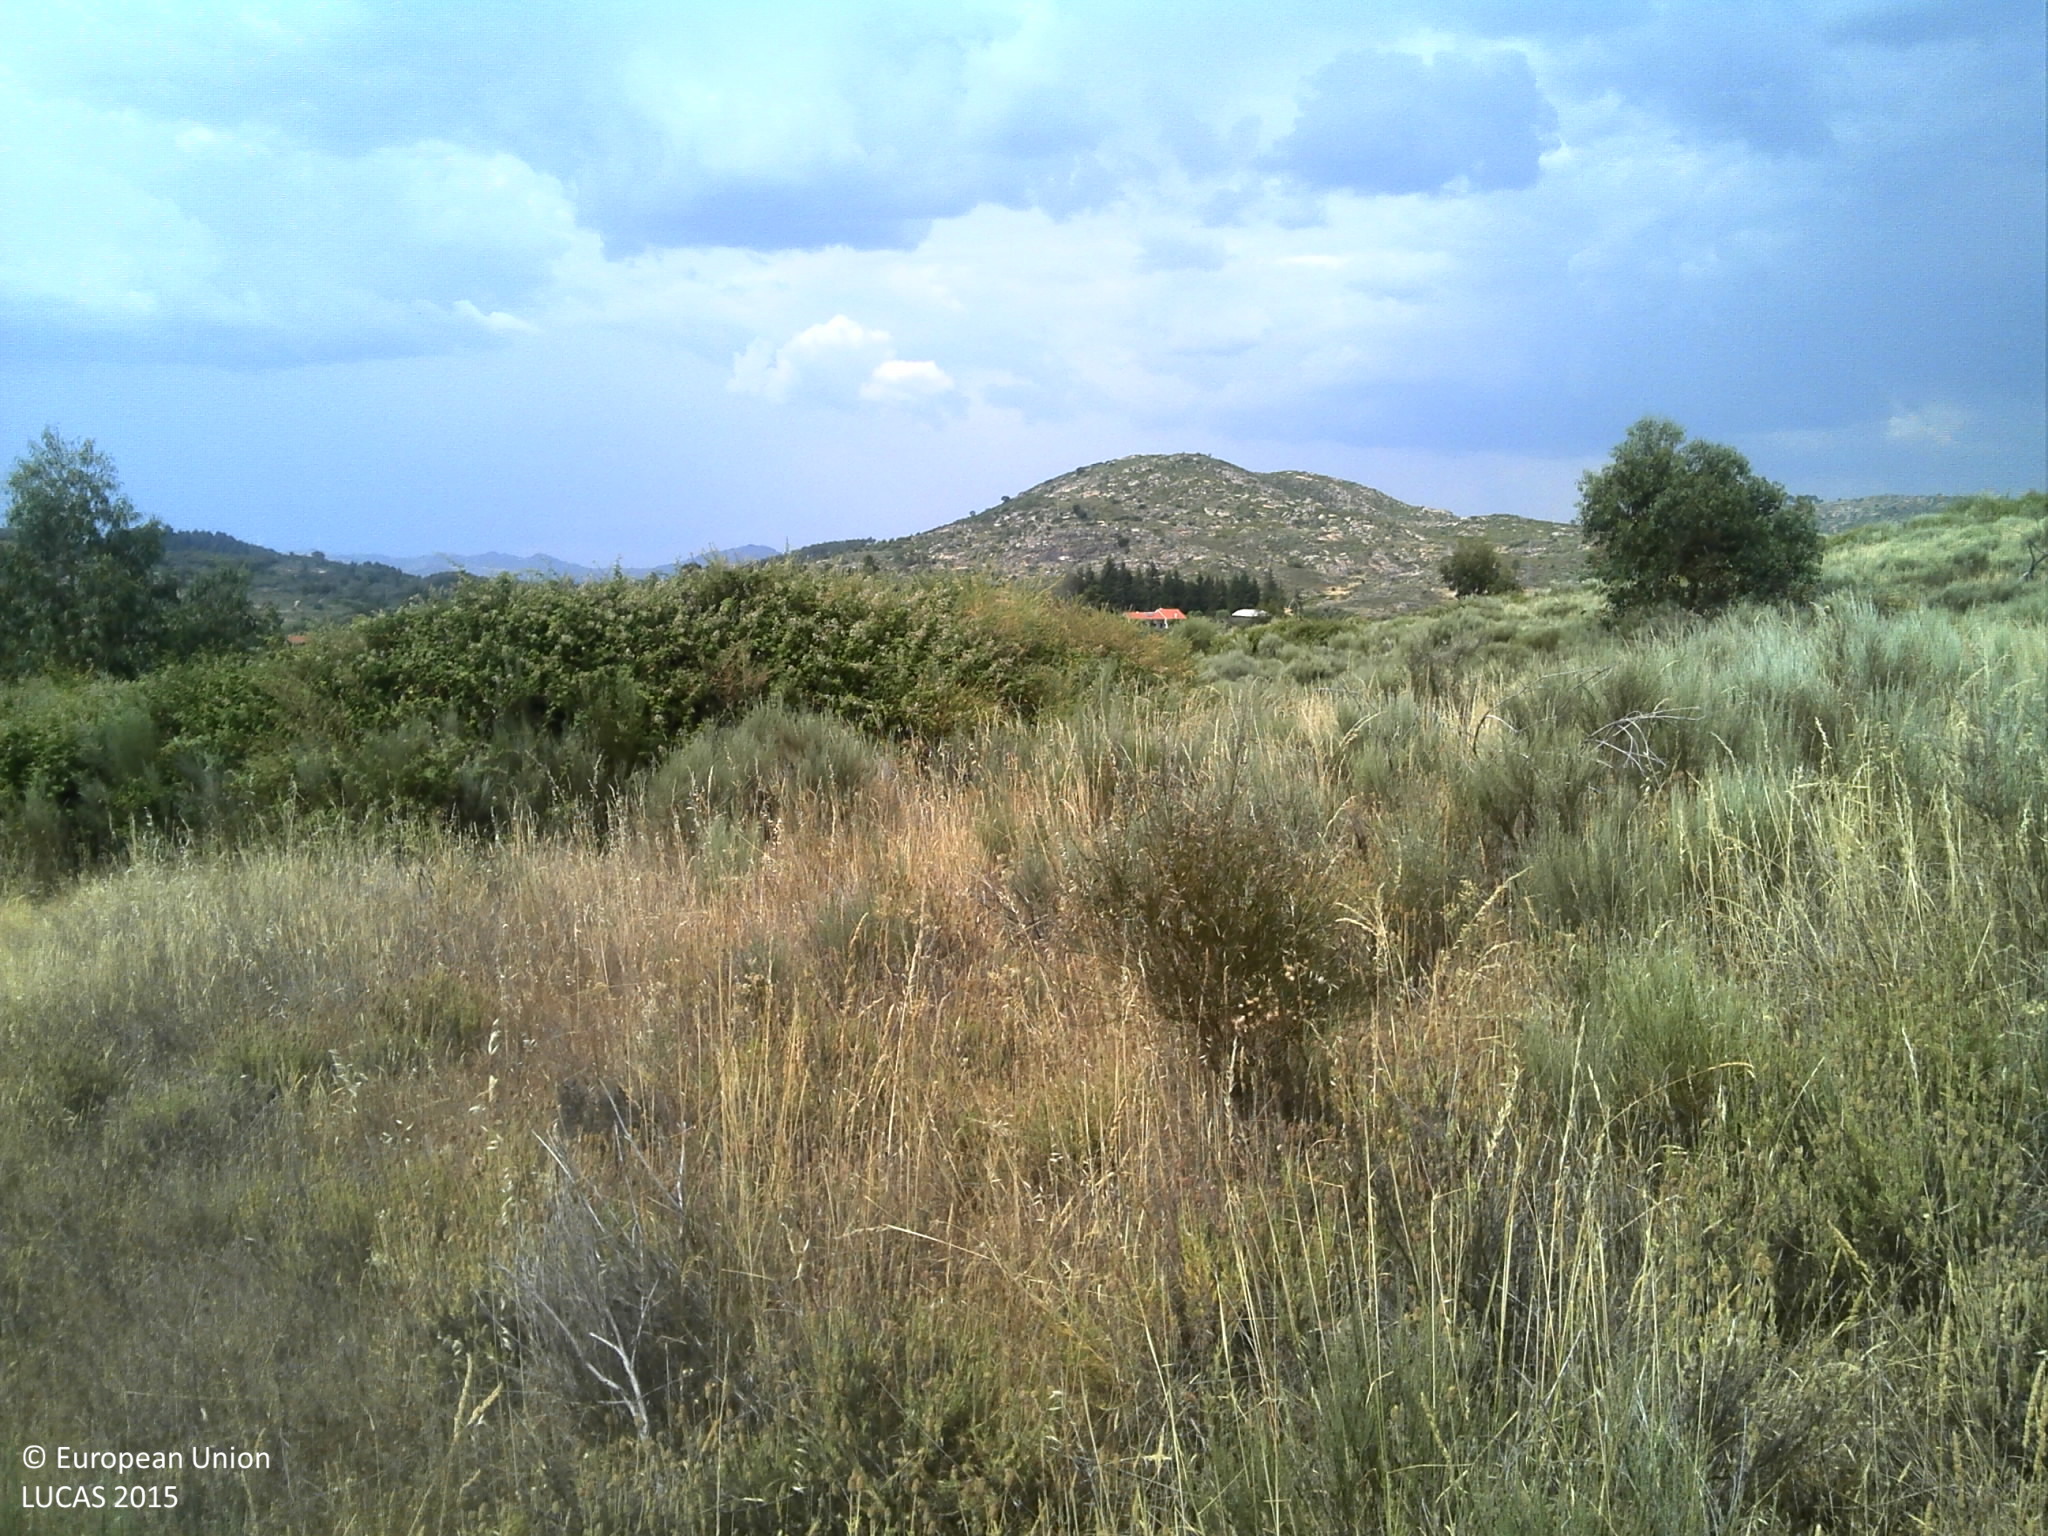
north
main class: Shrubland
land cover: Shrubland without tree cover
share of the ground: 50 - 75 %
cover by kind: shrubs 55 %, herbaceous plants 25 %, unconsolidated bare surface 20 %
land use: Abandoned areas
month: June
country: PT
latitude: 40.3053
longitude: -7.2924
